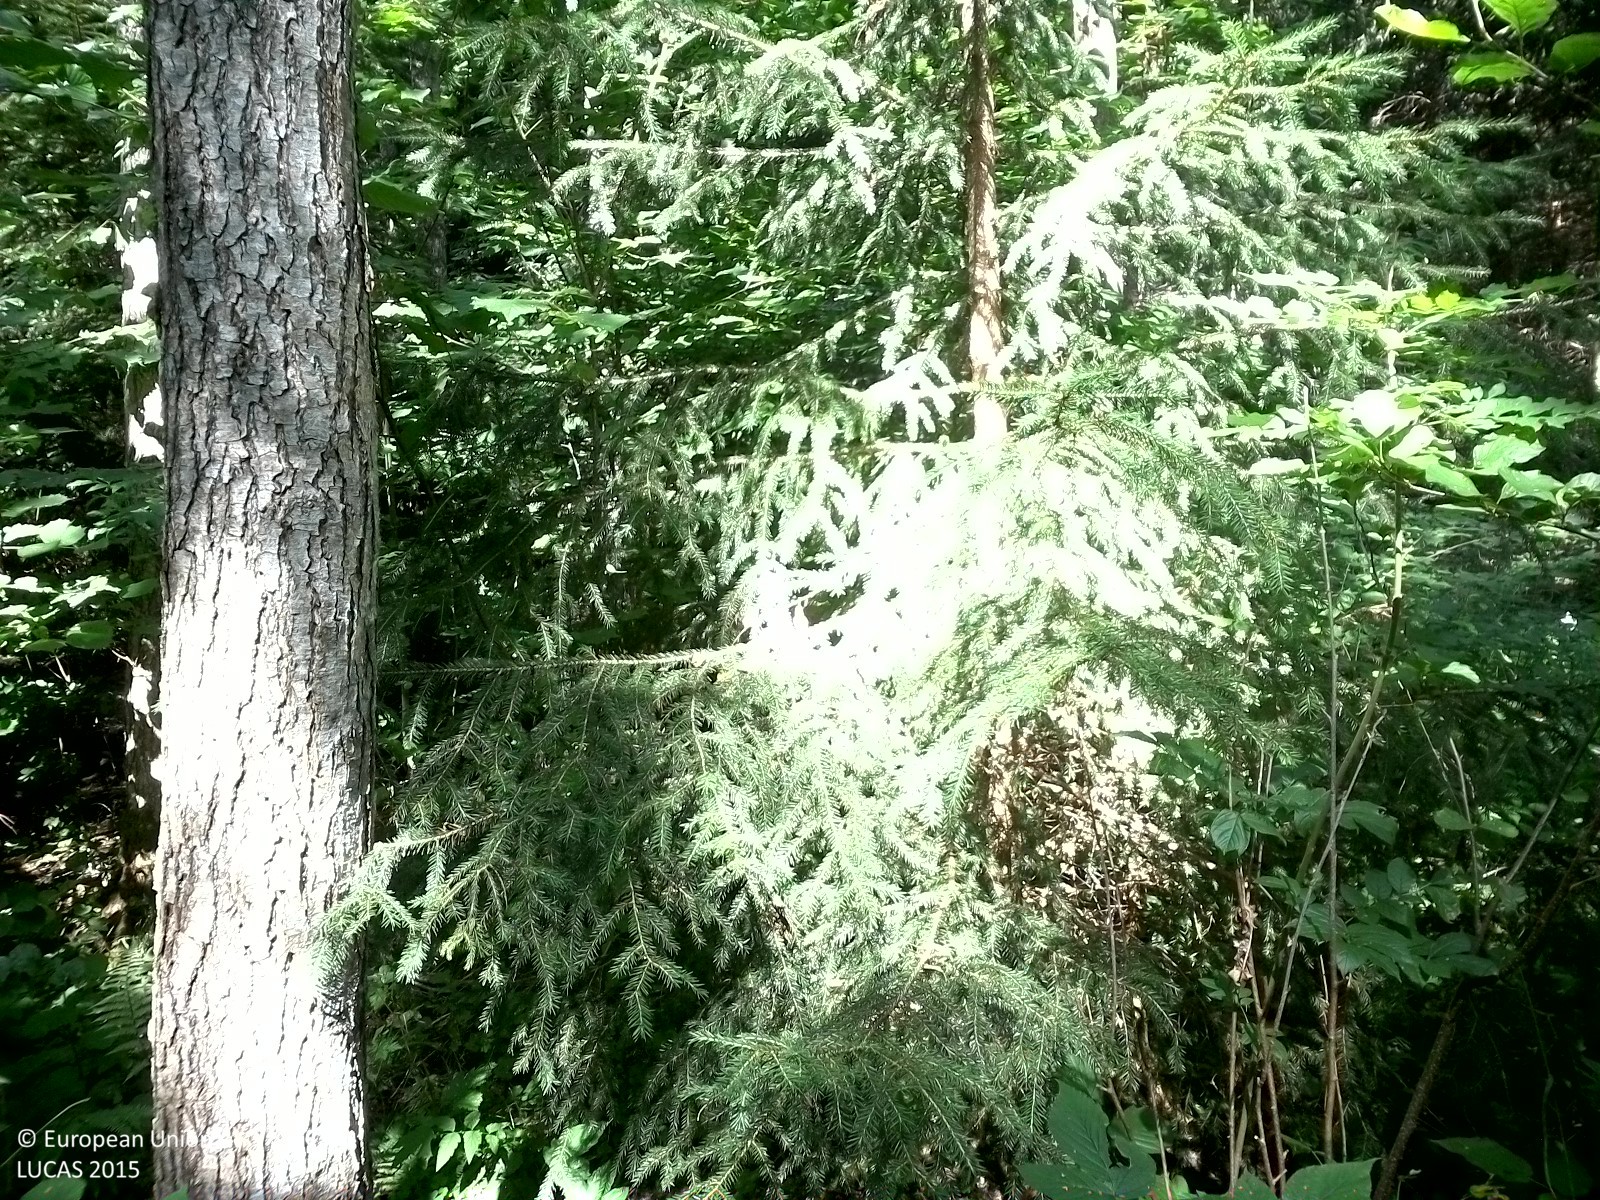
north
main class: Woodland
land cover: Spruce dominated mixed woodland
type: boreal forest
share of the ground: 50 - 75 %
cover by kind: coniferous forest trees 30 %, broadleaved forest trees 25 %, herbaceous plants 20 %, shrubs 15 %, unconsolidated bare surface 10 %
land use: Forestry
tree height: > 5 m
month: August
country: SE
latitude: 59.2579
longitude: 15.5868
